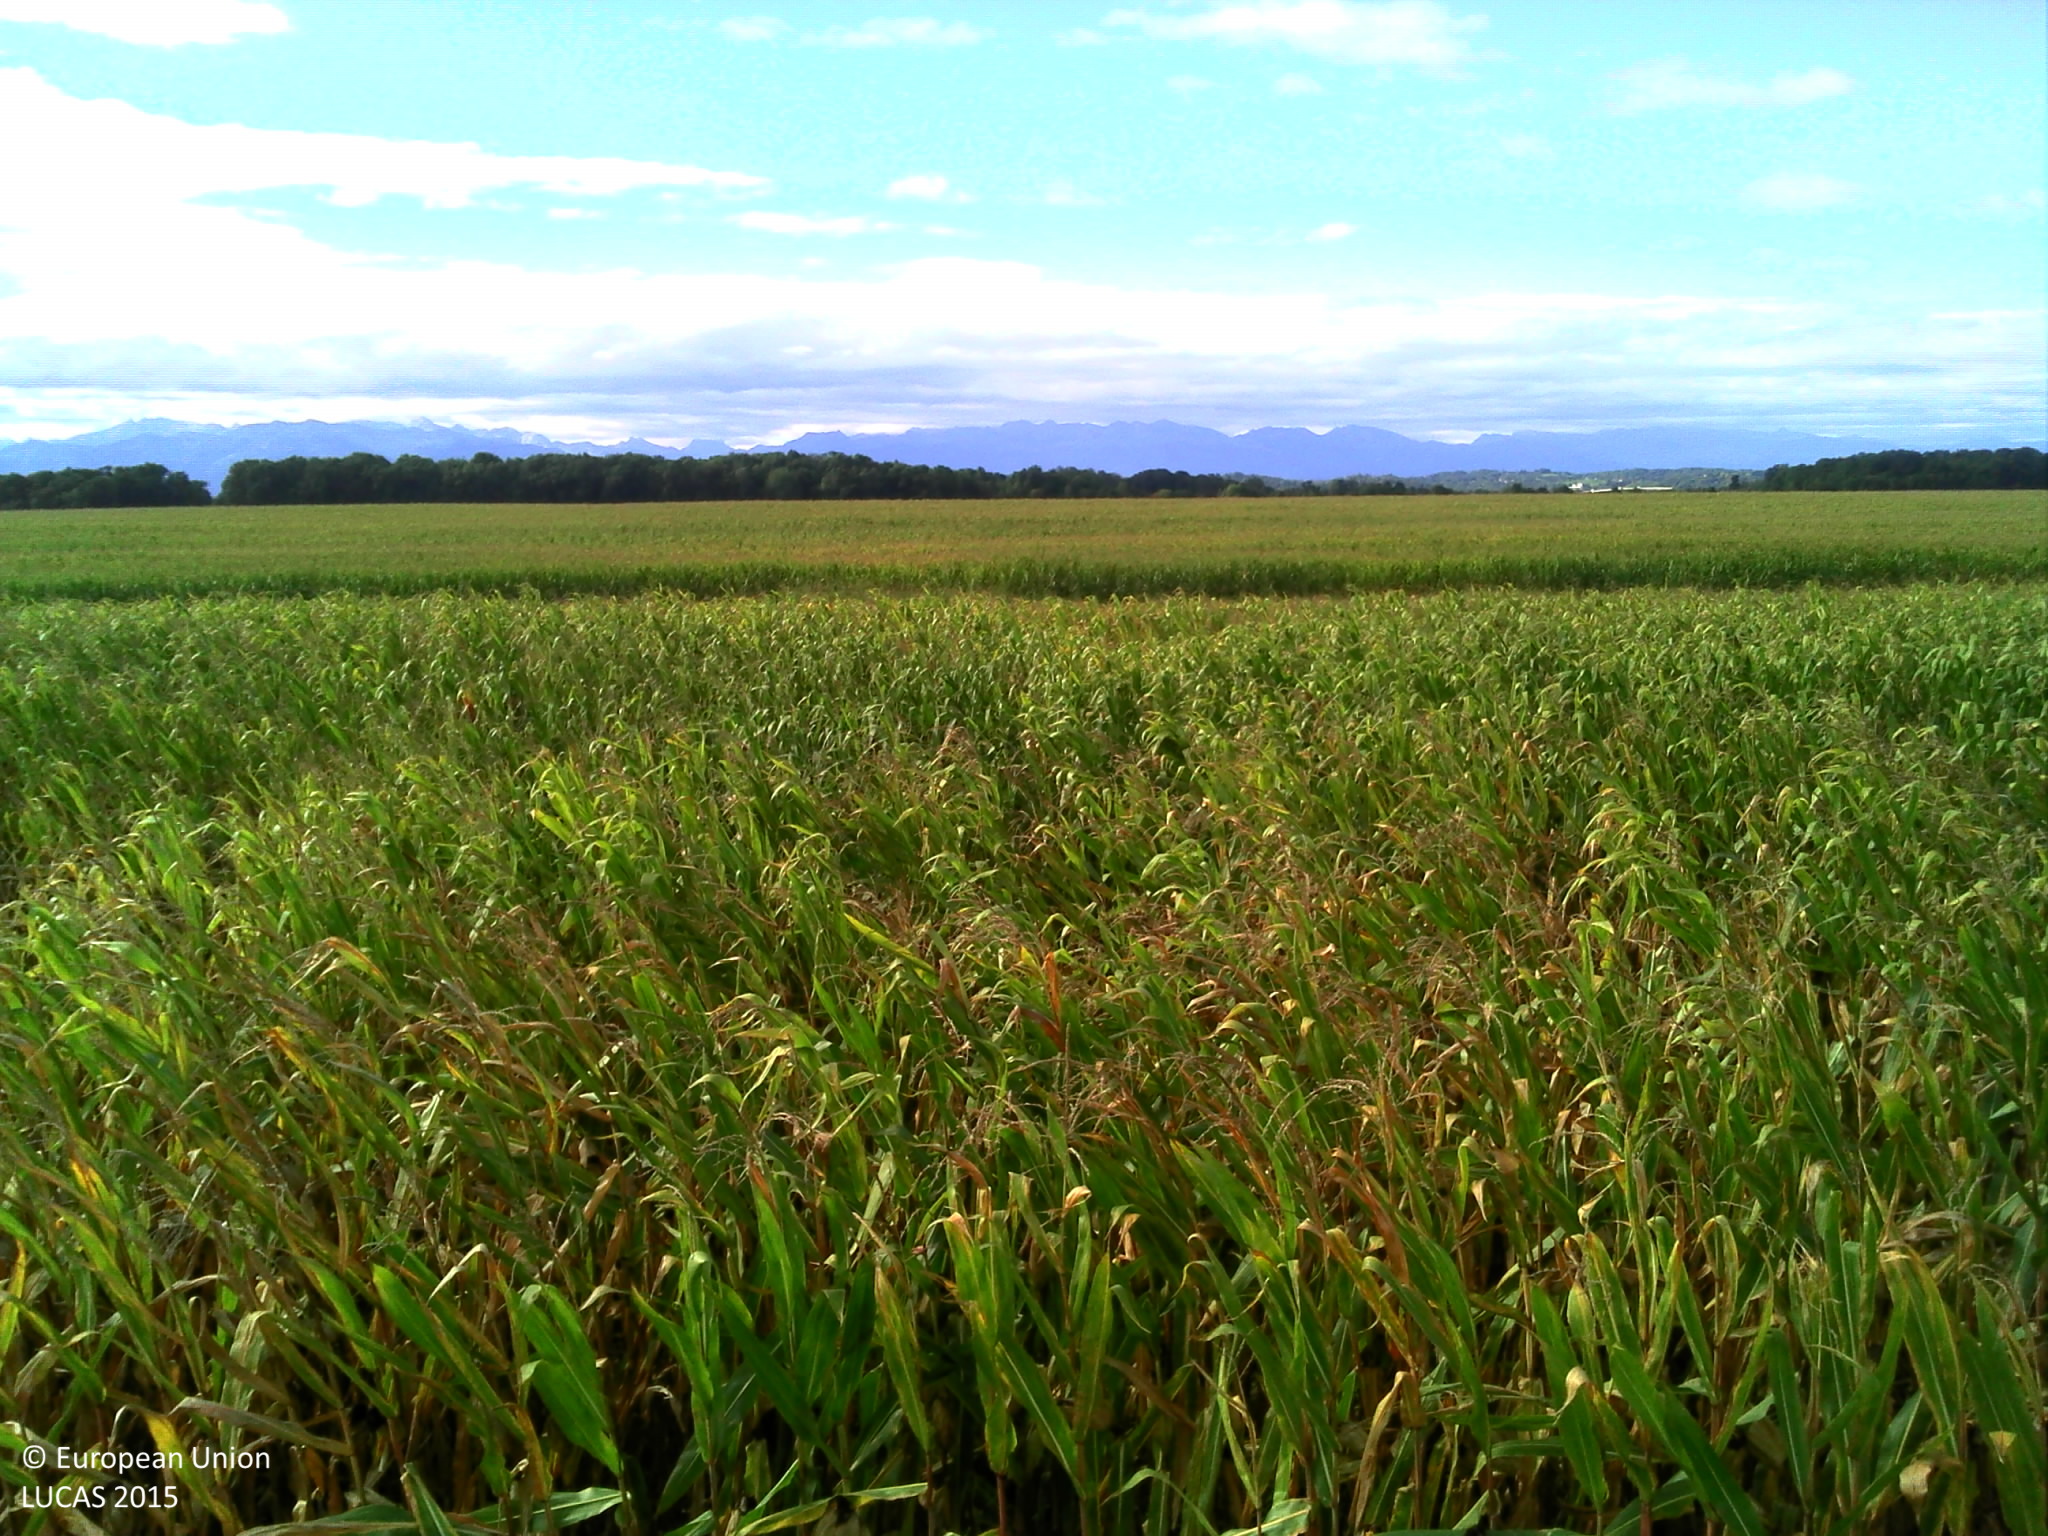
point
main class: Cropland
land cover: Maize
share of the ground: > 75 %
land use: Agriculture (excluding fallow land and kitchen gardens)
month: September
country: FR
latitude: 43.3532
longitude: -0.4081
